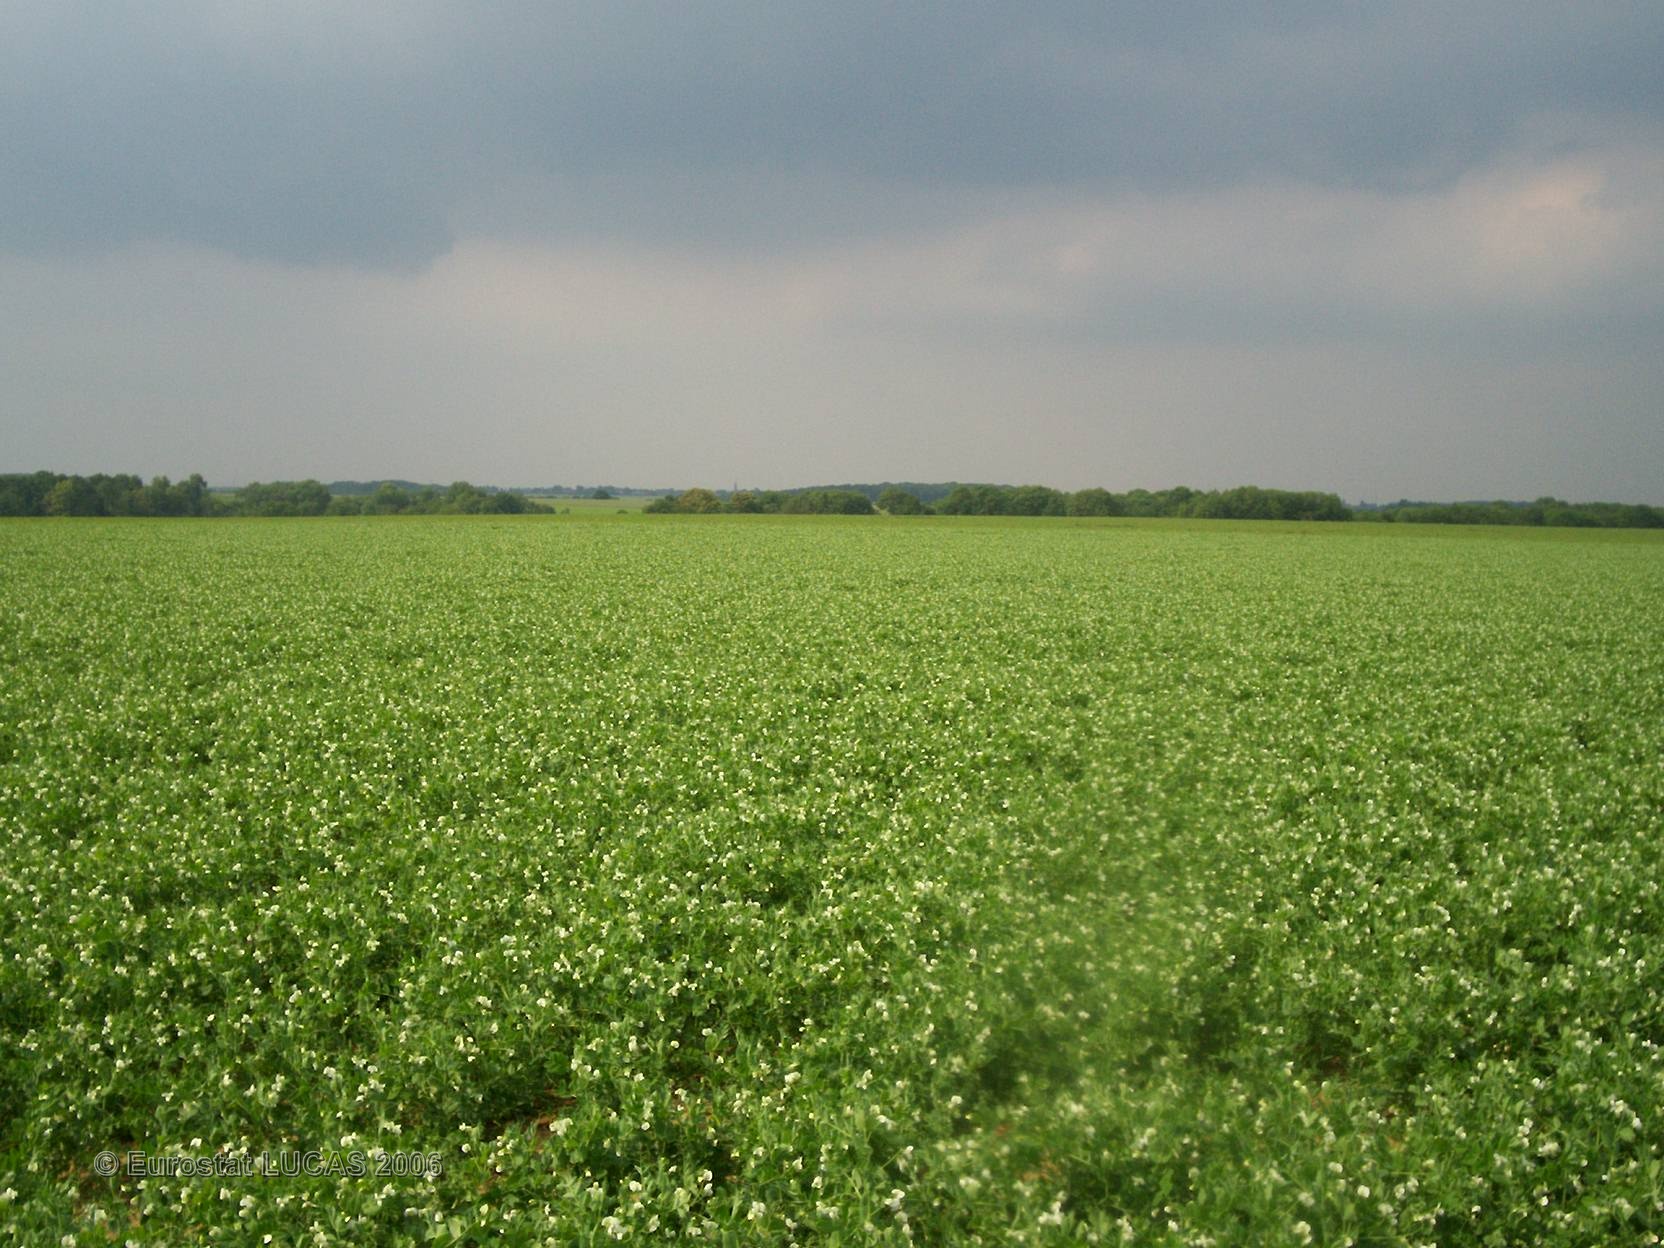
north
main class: Cropland
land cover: Other fresh vegetables
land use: Agriculture (excluding fallow land and kitchen gardens)
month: June
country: FR
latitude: 49.6801
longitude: 2.7130
